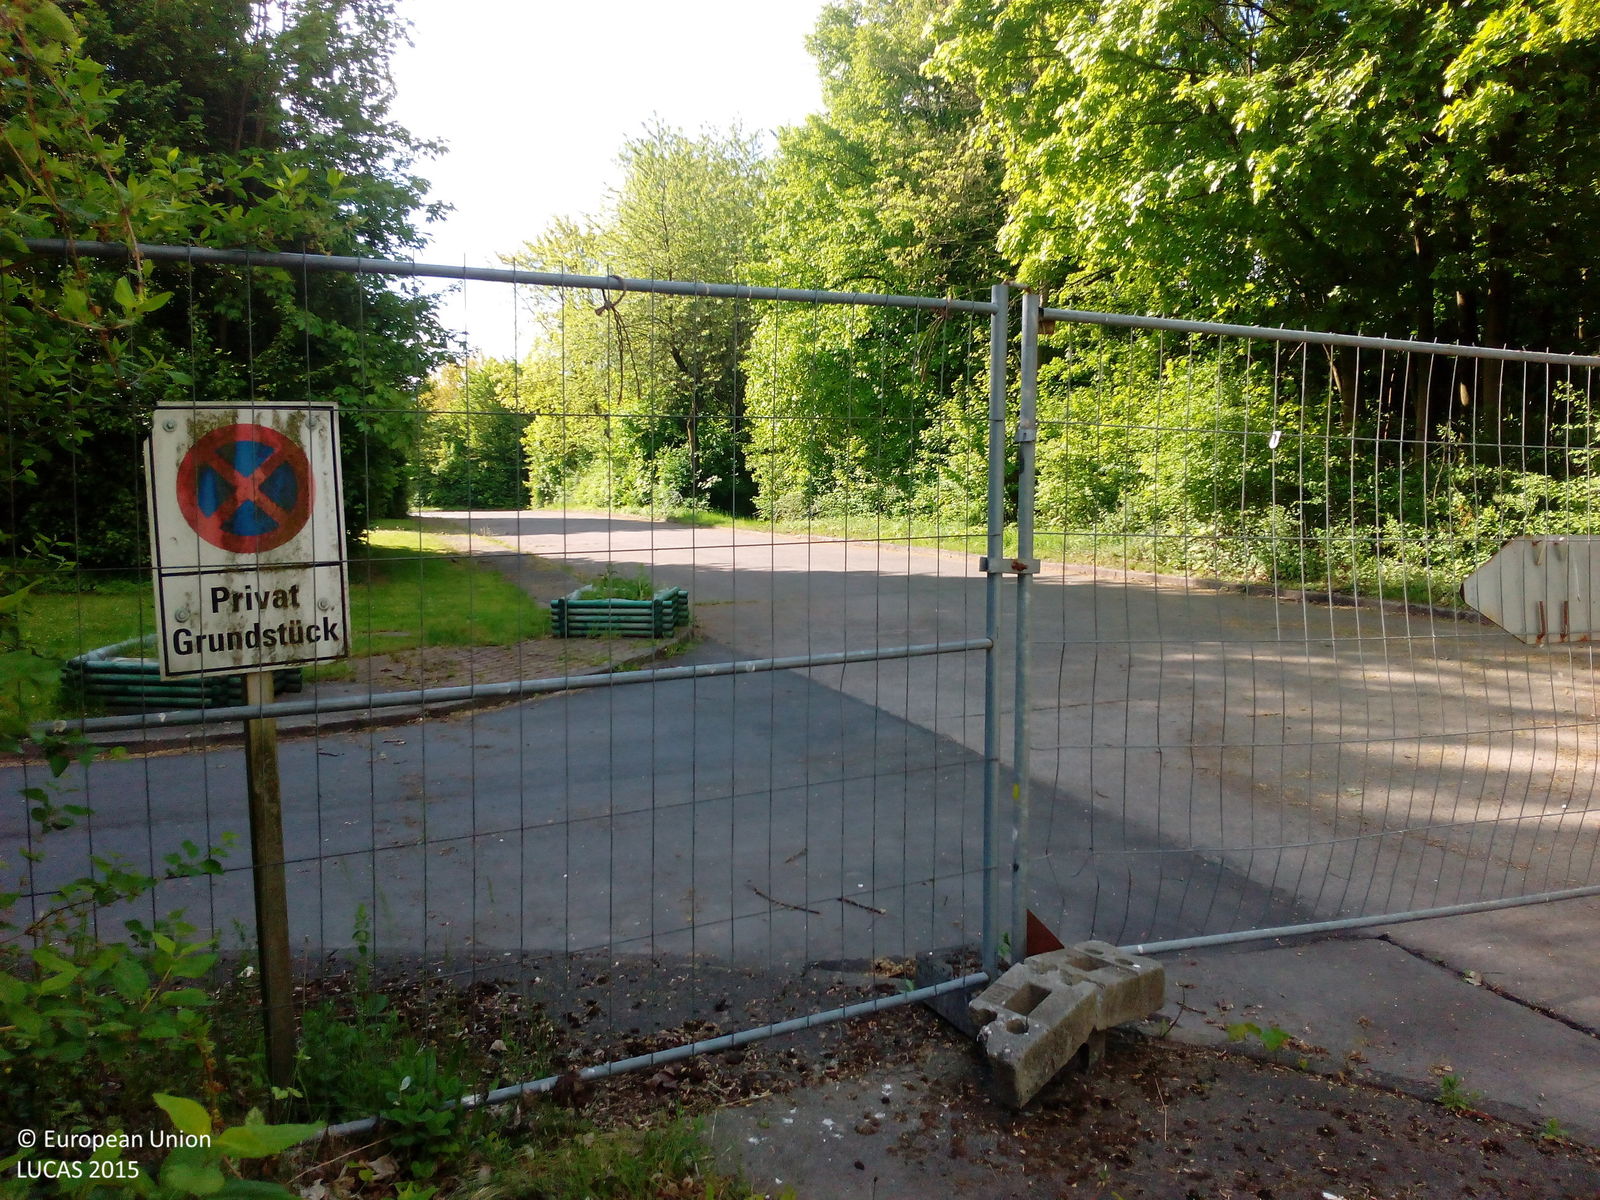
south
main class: Shrubland
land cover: Shrubland without tree cover
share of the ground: > 75 %
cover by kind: shrubs 100 %
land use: Road transport
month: May
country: DE
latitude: 51.8736
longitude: 9.6370
